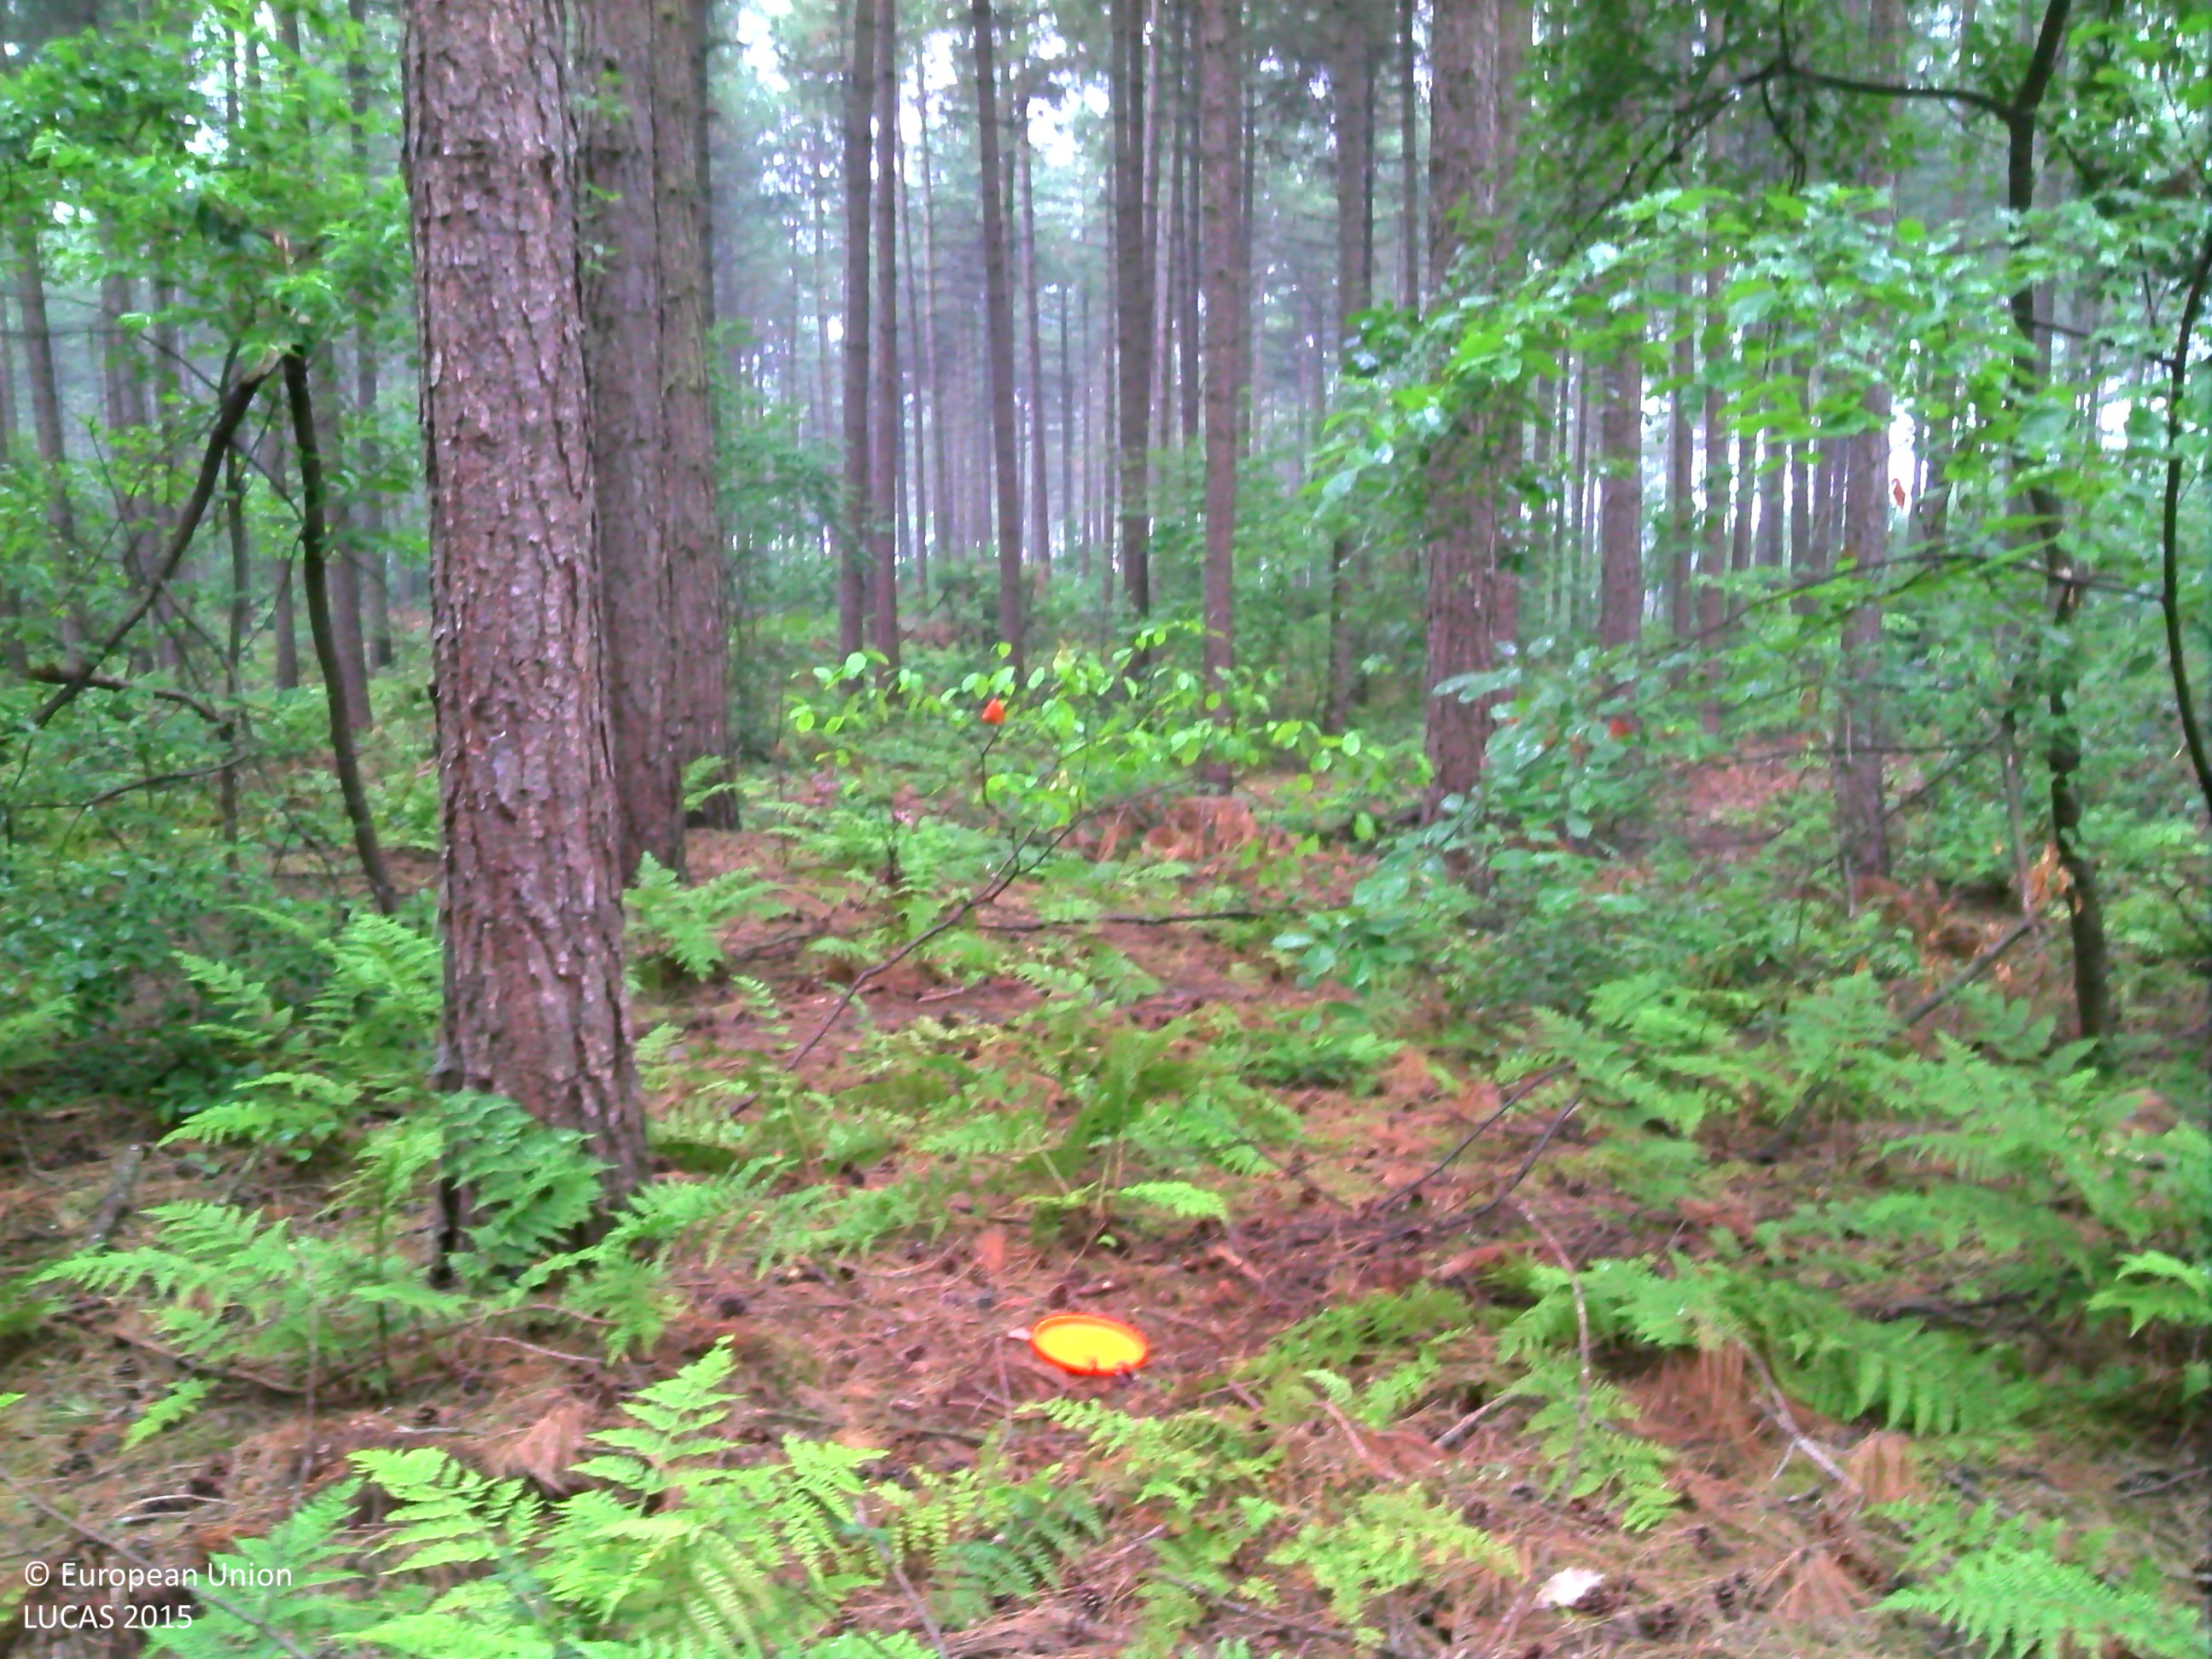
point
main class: Woodland
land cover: Pine dominated coniferous woodland
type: exotic forest
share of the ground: > 75 %
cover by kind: coniferous forest trees 90 %, broadleaved forest trees 10 %
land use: Forestry
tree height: > 5 m
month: August
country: BE
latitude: 50.9256
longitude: 5.5452
